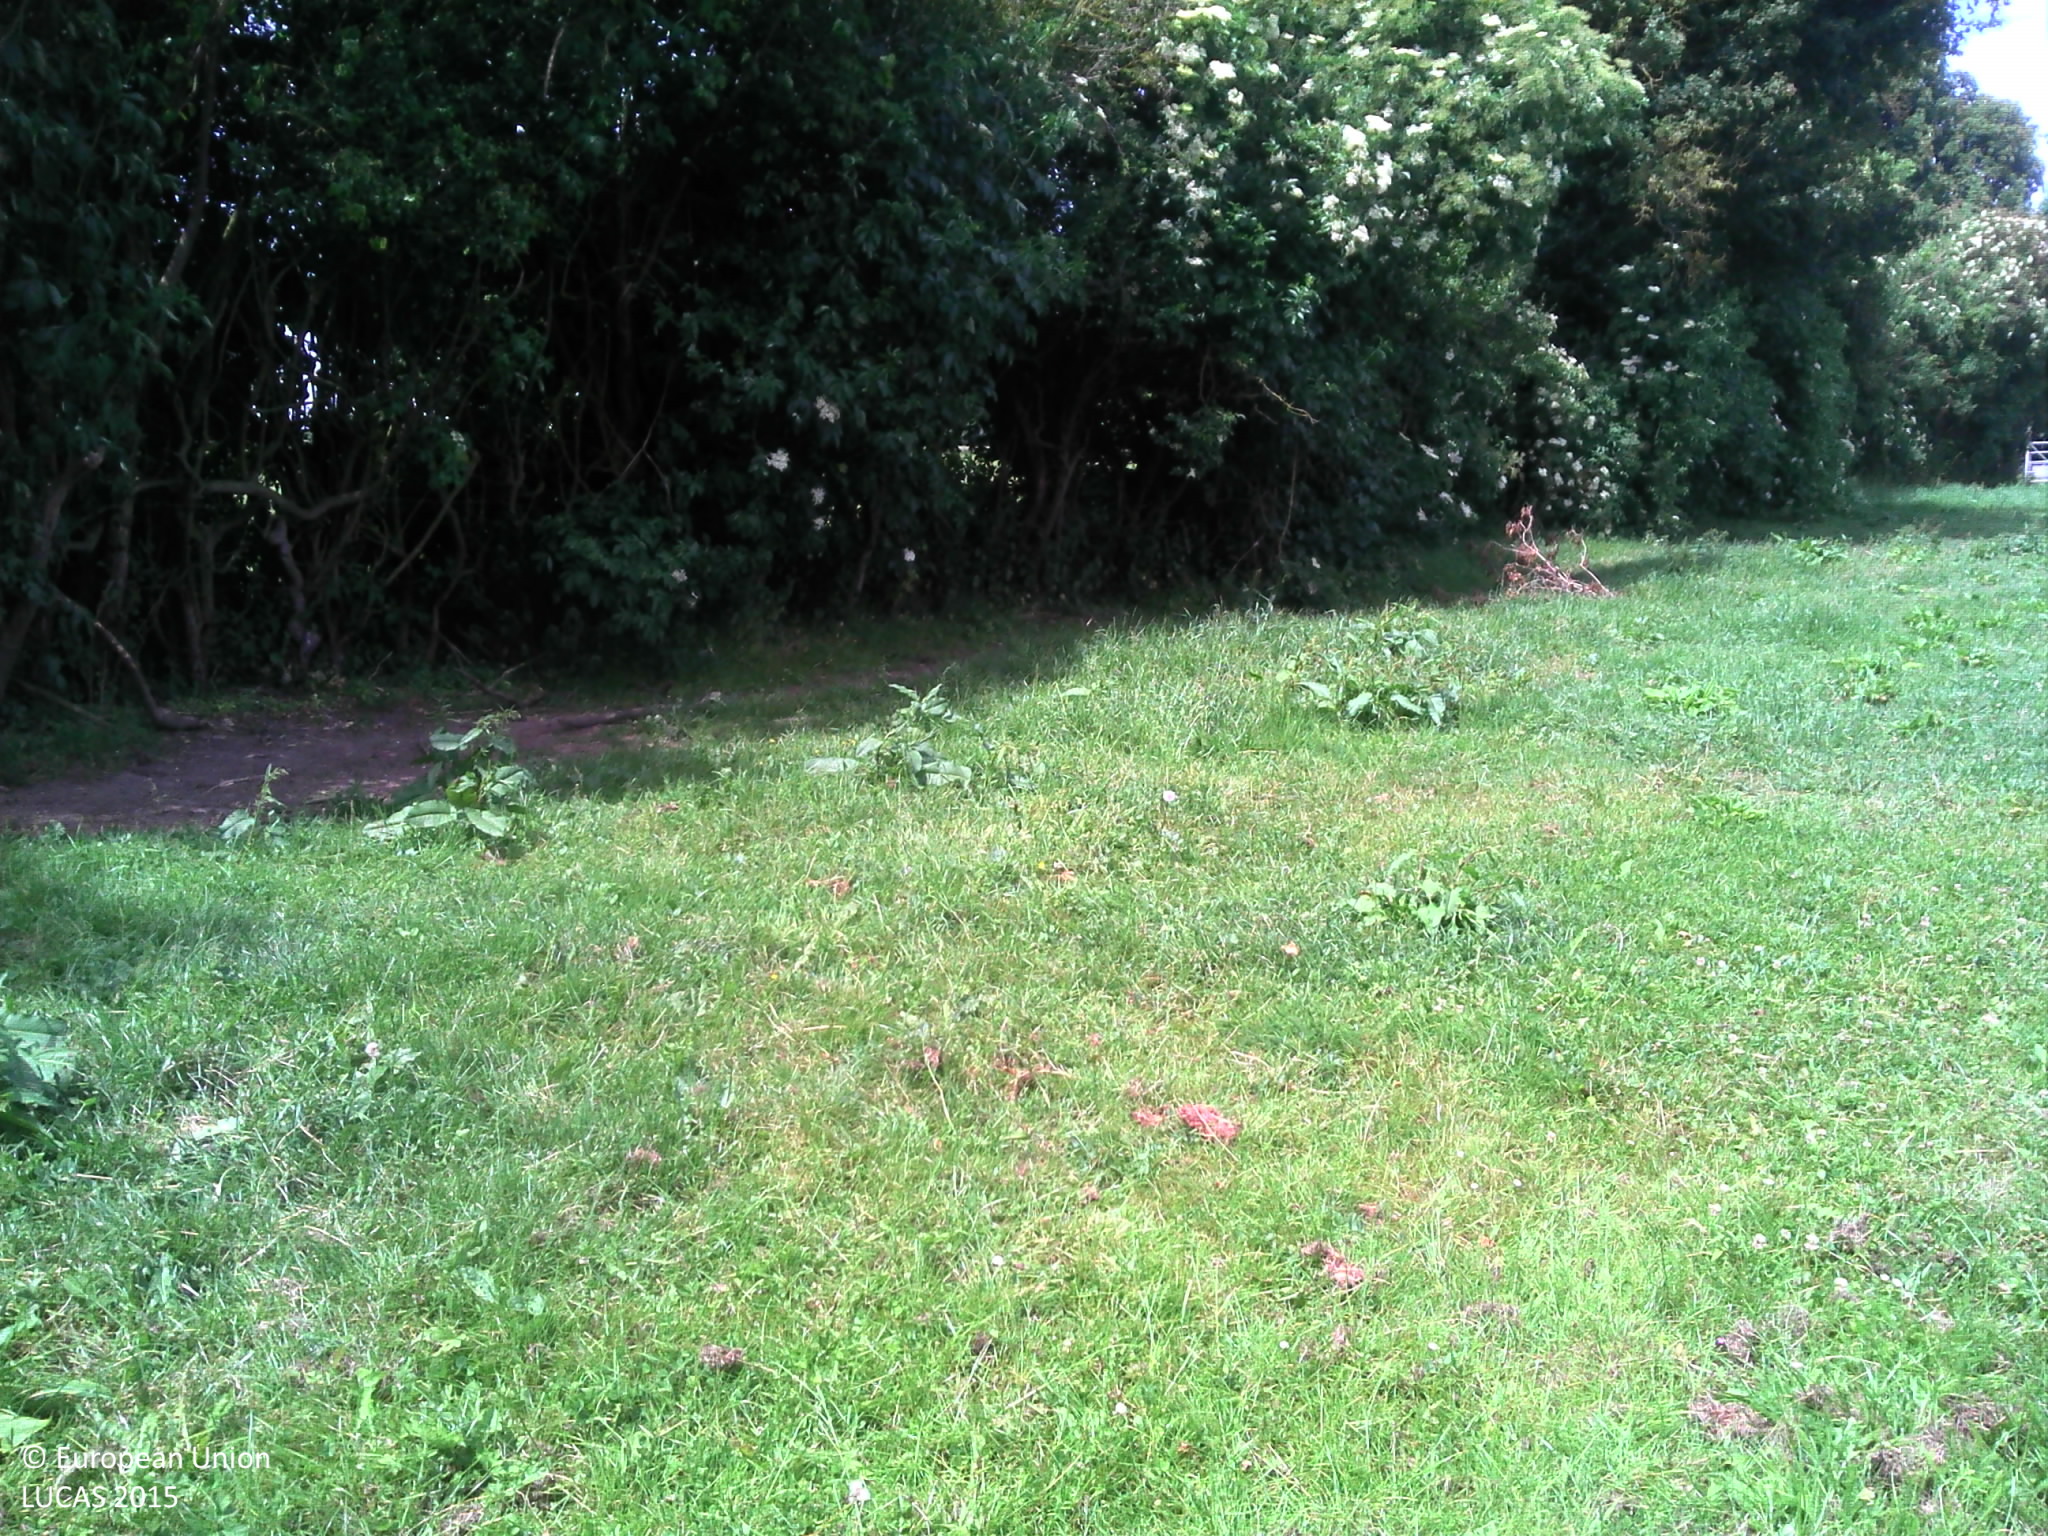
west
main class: Grassland
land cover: Grassland without tree/shrub cover
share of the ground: > 75 %
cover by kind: herbaceous plants 100 %
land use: Agriculture (excluding fallow land and kitchen gardens)
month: June
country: FR
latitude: 49.6902
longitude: 2.3211
